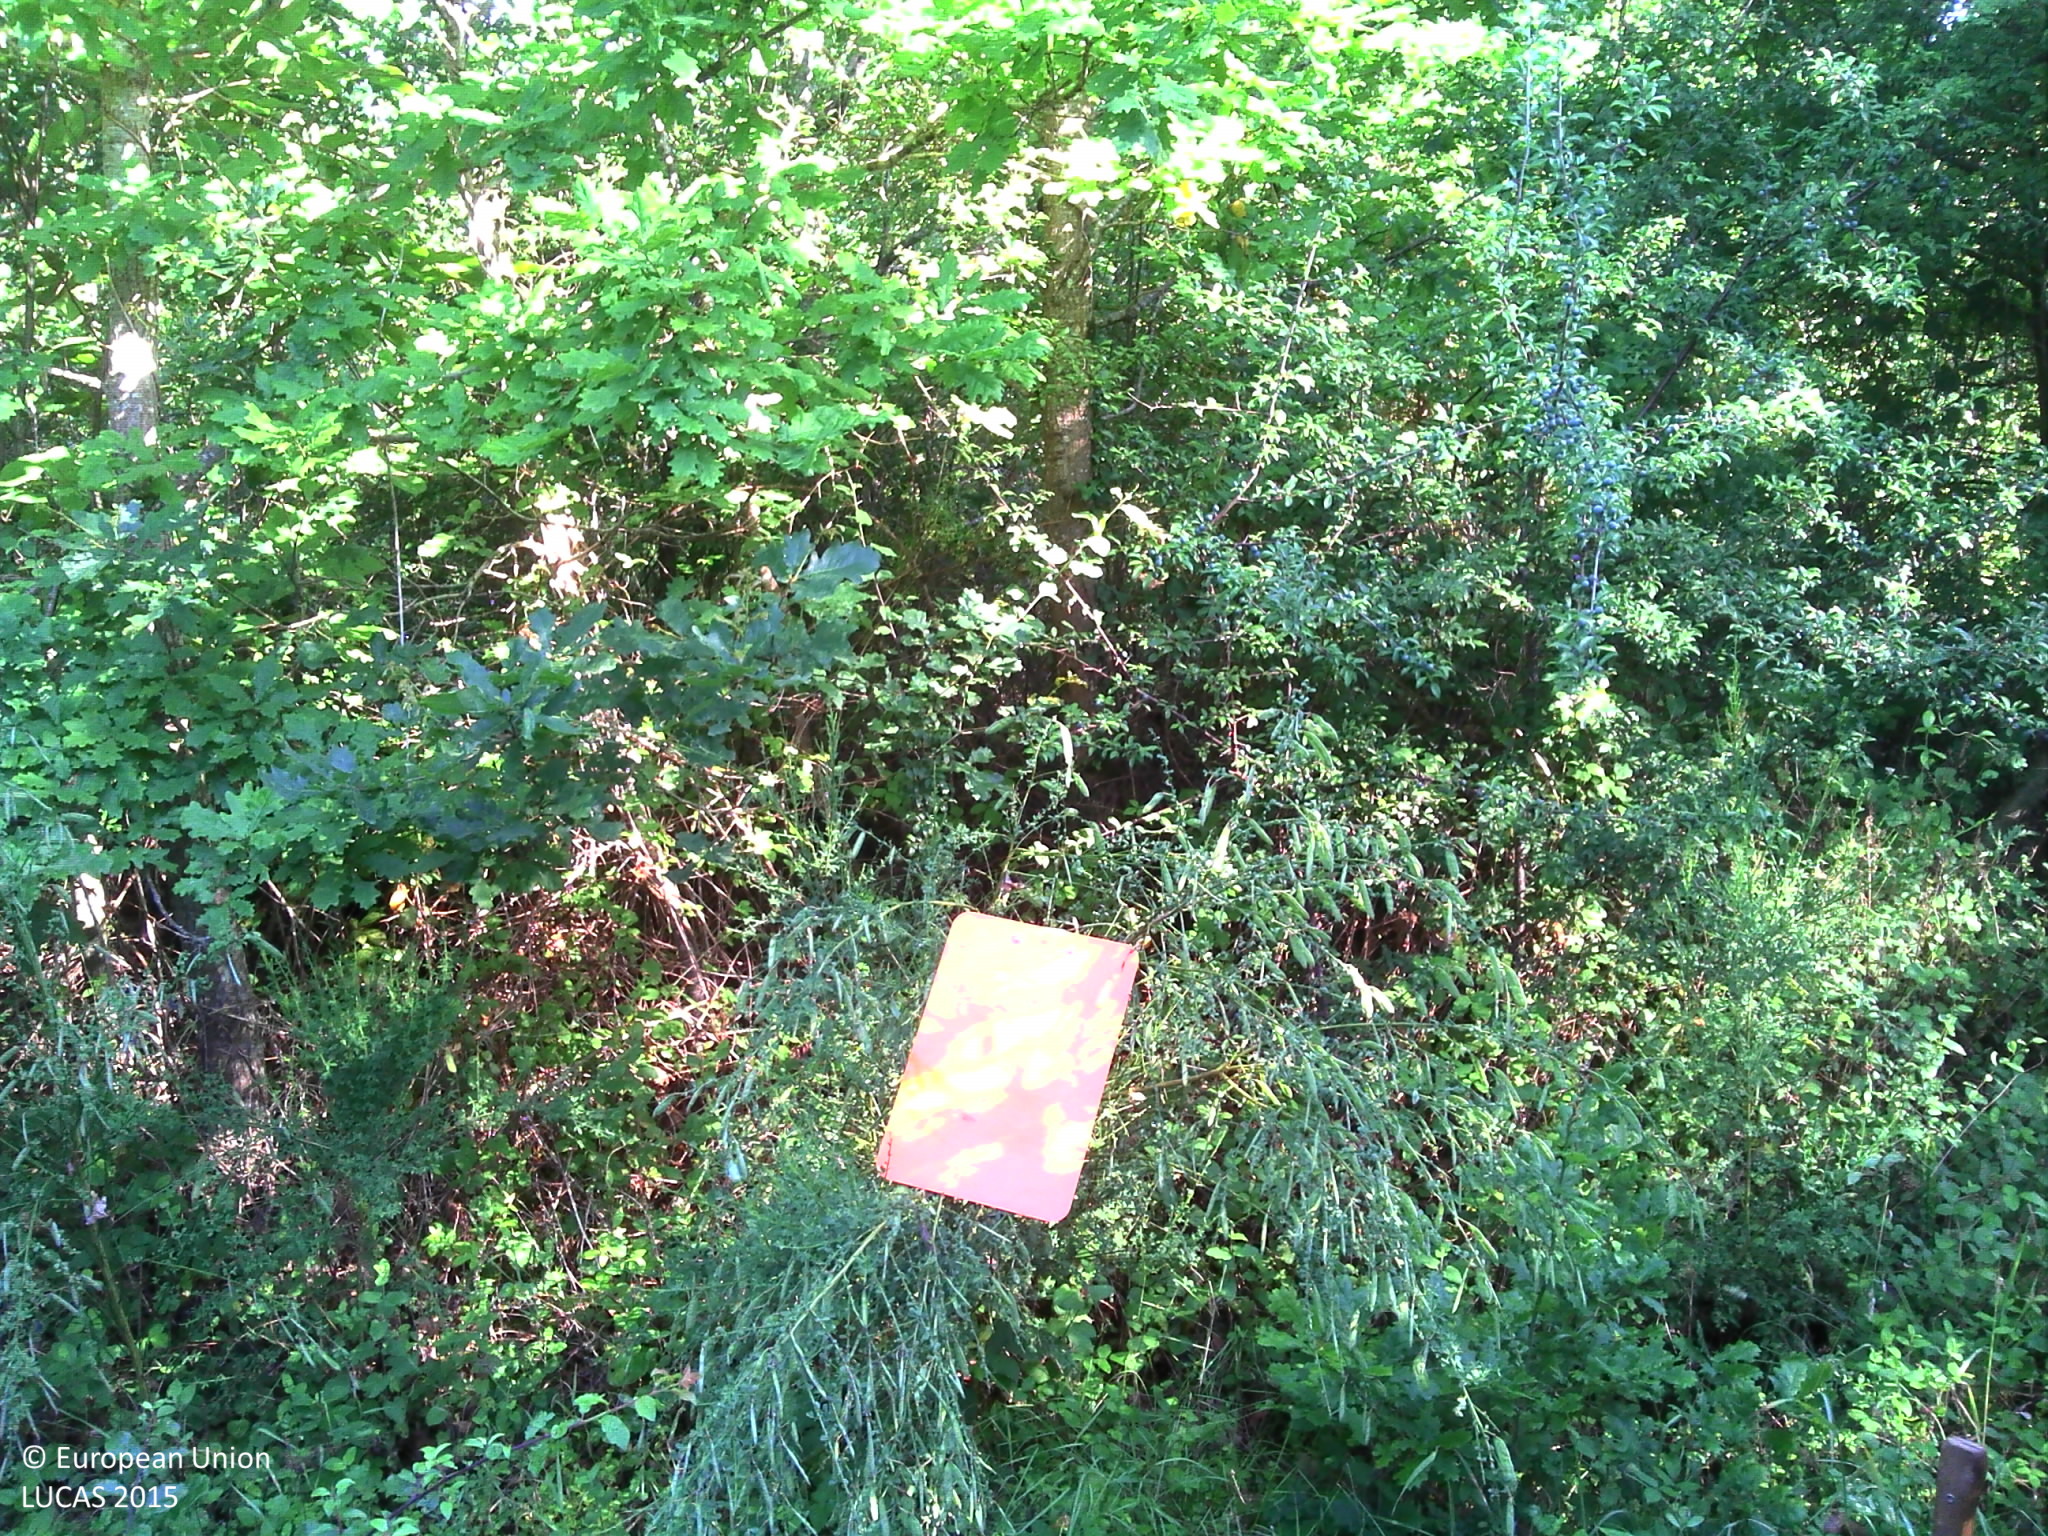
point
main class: Woodland
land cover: Broadleaved woodland
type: acidophilous oak and oak-birch forest
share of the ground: > 75 %
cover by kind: broadleaved forest trees 85 %, shrubs 10 %, herbaceous plants 5 %
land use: Semi-natural and natural areas not in use
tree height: > 5 m
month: June
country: FR
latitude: 45.8809
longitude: 0.3852
